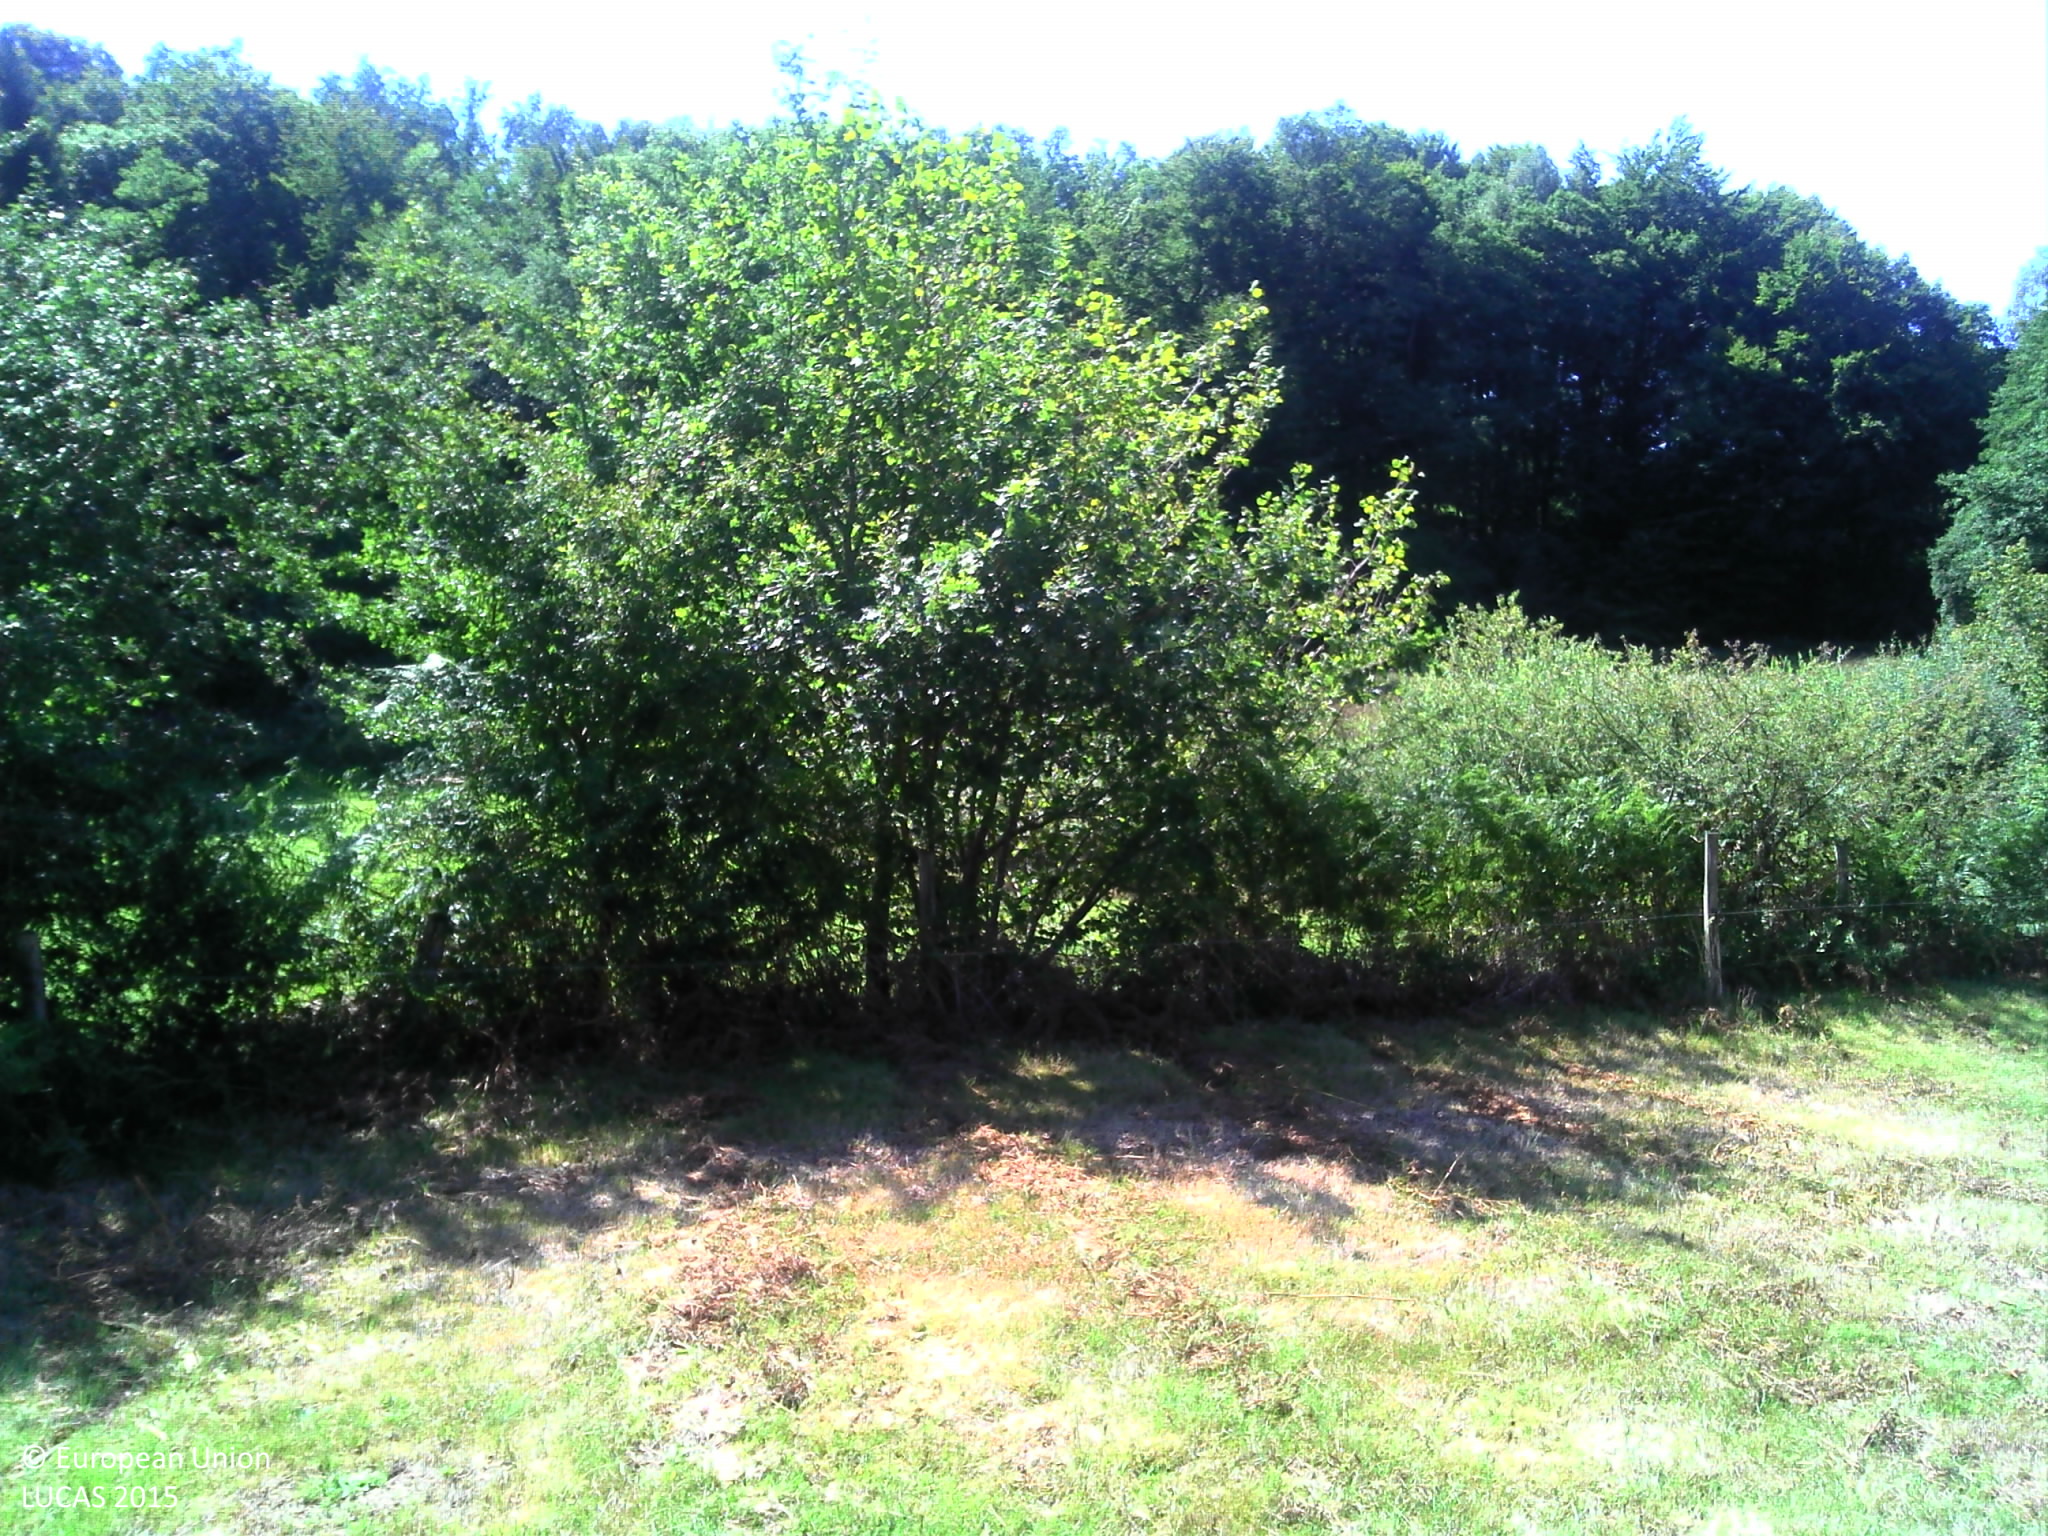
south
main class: Grassland
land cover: Grassland without tree/shrub cover
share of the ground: > 75 %
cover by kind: herbaceous plants 100 %
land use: Agriculture (excluding fallow land and kitchen gardens)
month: August
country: FR
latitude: 45.8204
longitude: 1.8211
